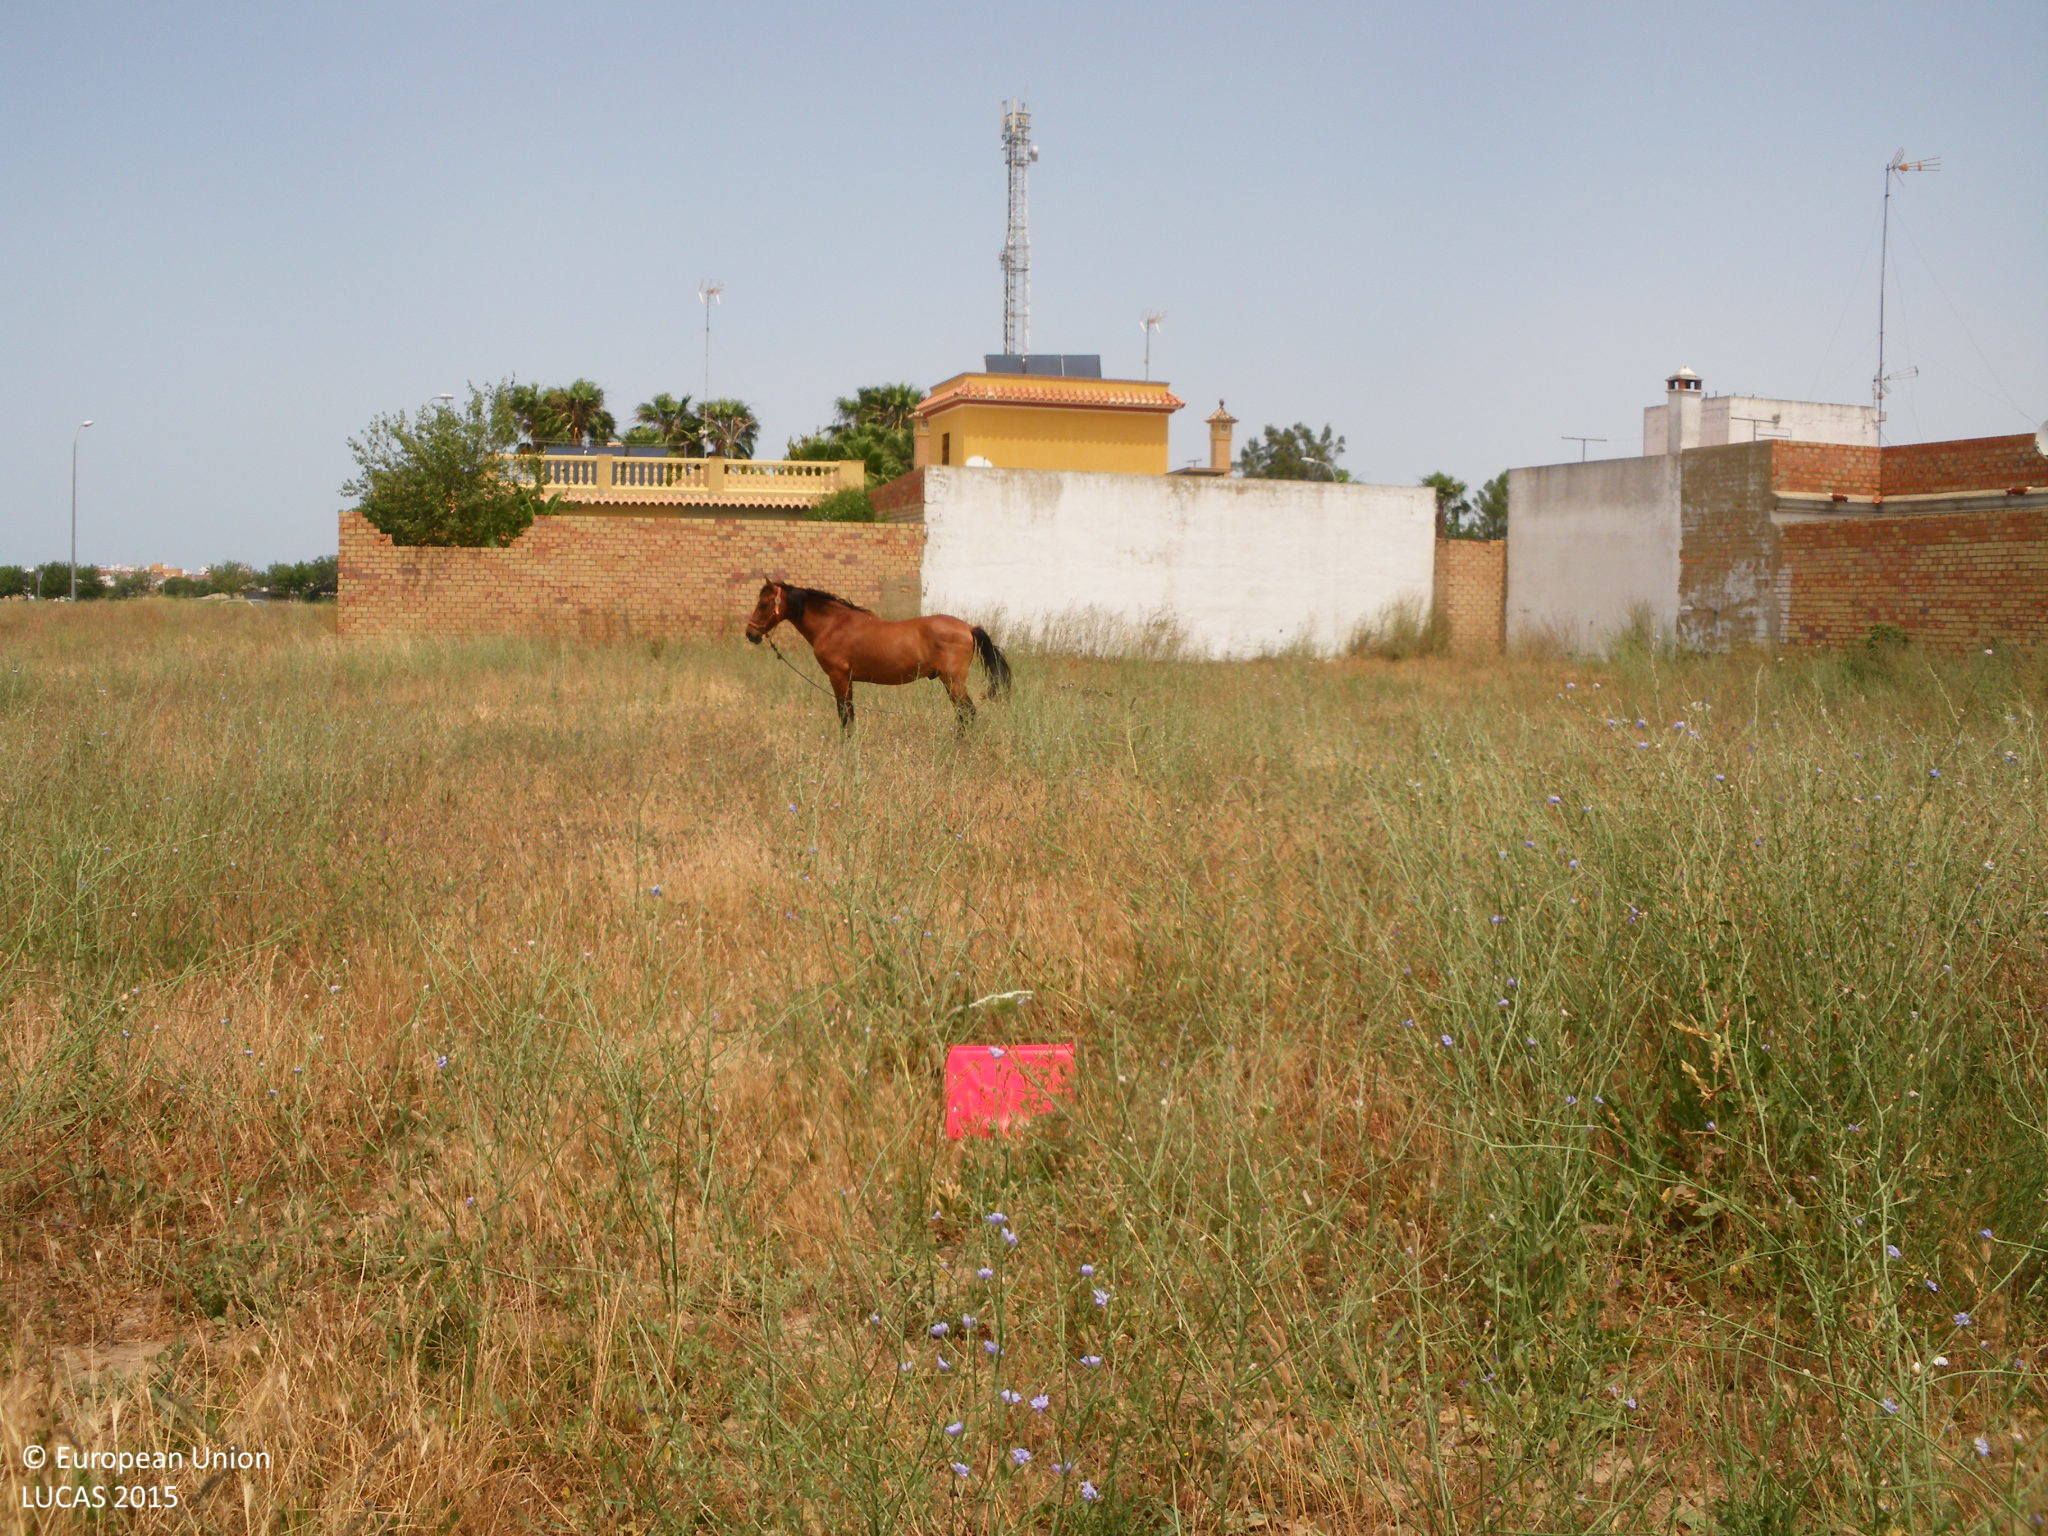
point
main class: Grassland
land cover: Grassland without tree/shrub cover
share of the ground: > 75 %
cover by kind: herbaceous plants 95 %, unconsolidated bare surface 5 %
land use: Agriculture (excluding fallow land and kitchen gardens)
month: June
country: ES
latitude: 36.7337
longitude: -6.4231
